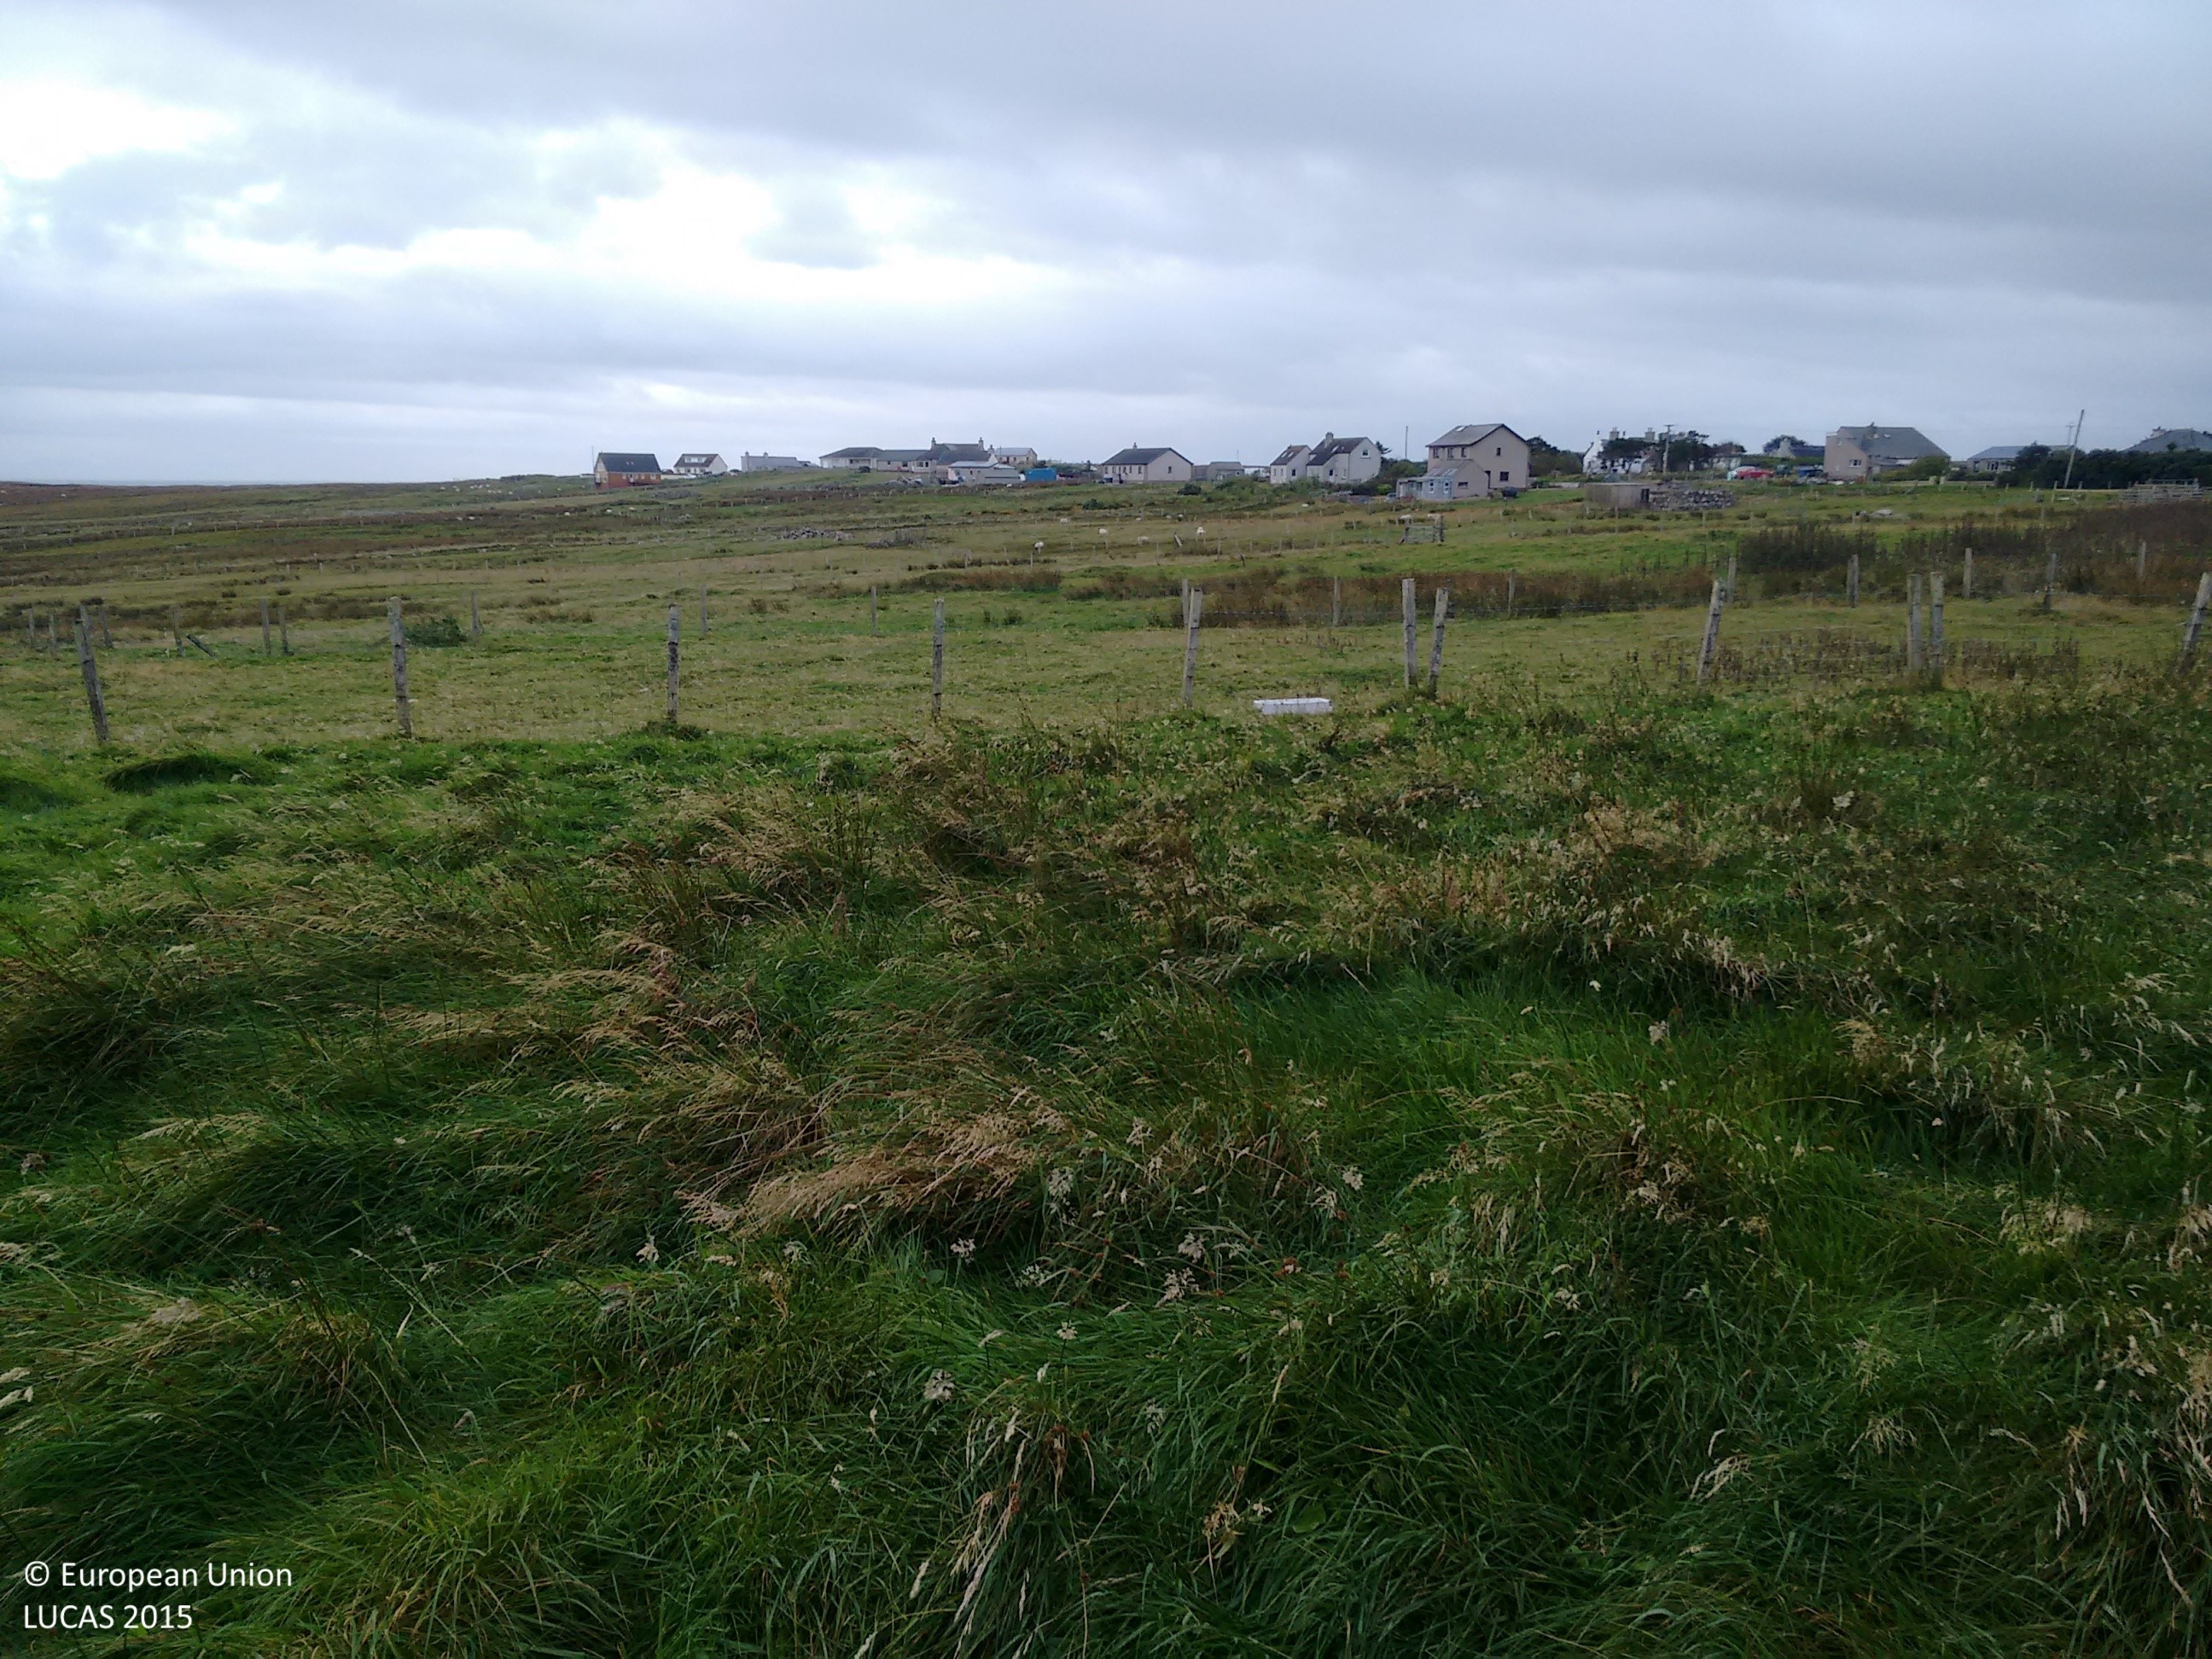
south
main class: Grassland
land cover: Grassland without tree/shrub cover
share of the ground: > 75 %
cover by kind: herbaceous plants 100 %
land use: Agriculture (excluding fallow land and kitchen gardens)
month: October
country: GB
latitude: 58.2442
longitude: -6.1585
